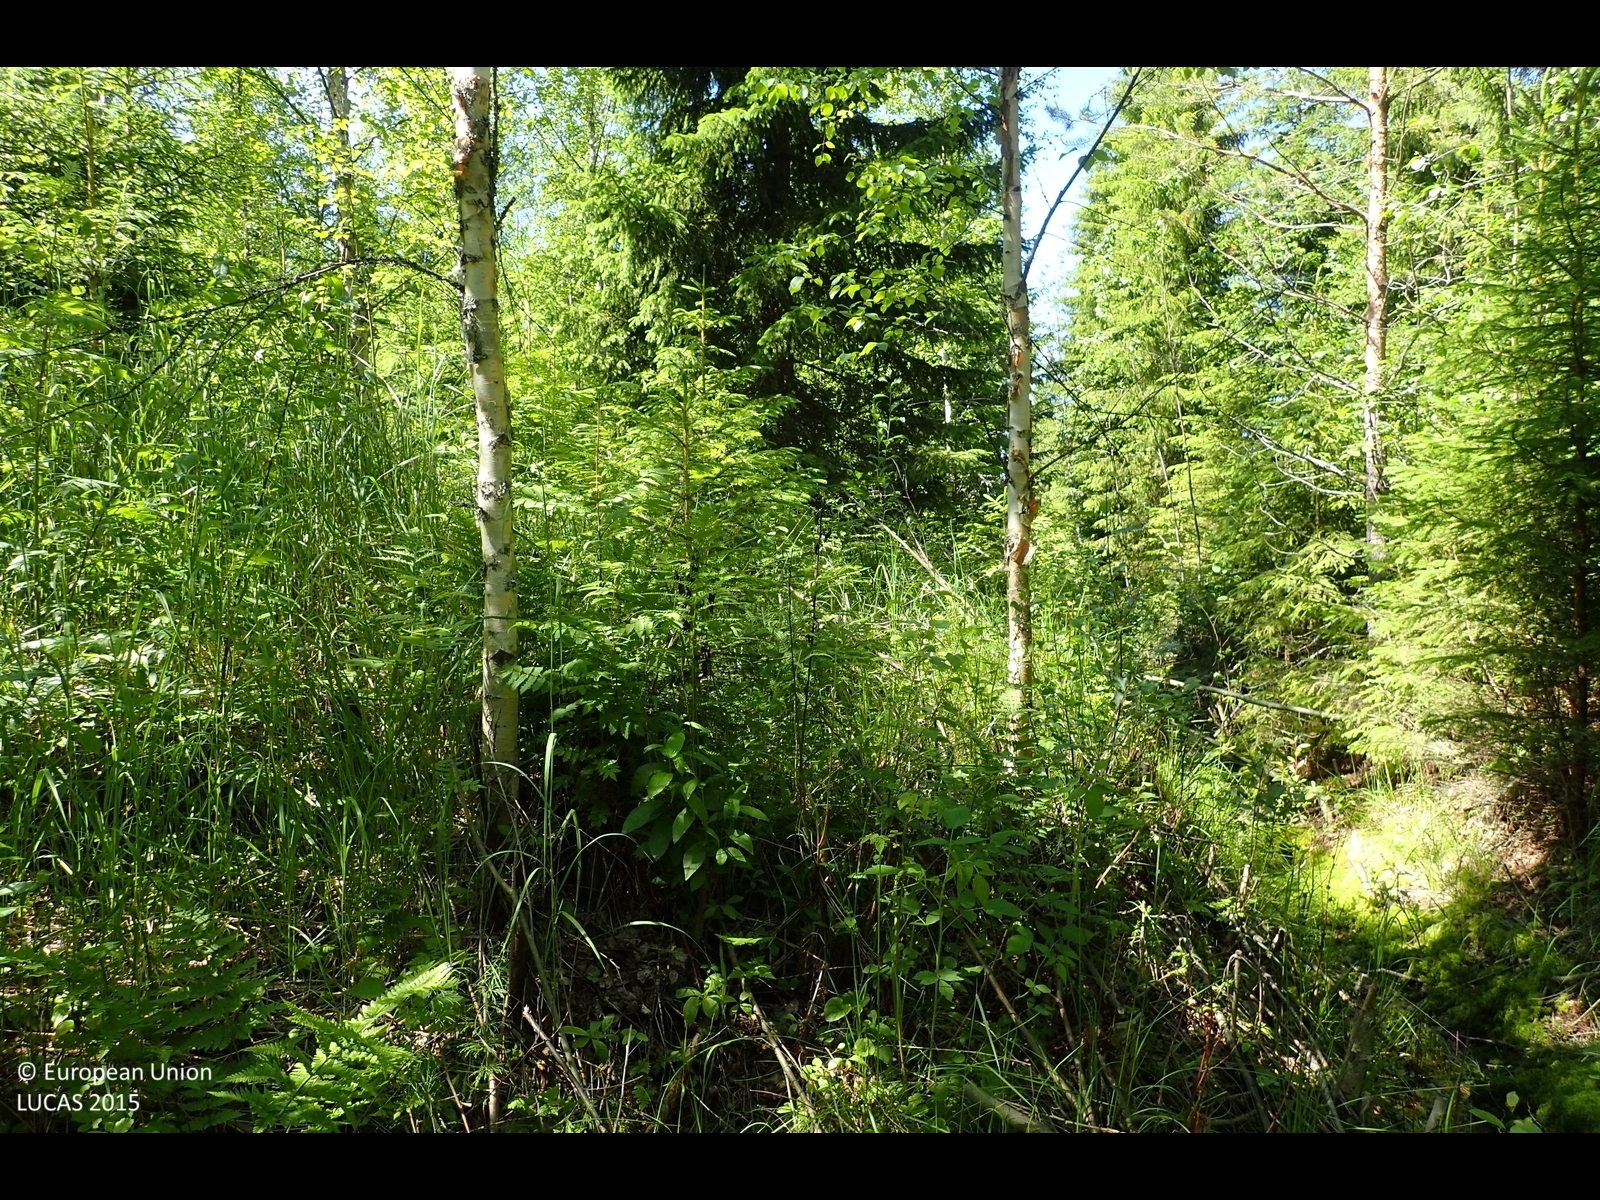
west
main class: Woodland
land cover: Broadleaved woodland
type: boreal forest
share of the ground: > 75 %
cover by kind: broadleaved forest trees 60 %, herbaceous plants 25 %, coniferous forest trees 15 %
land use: Forestry
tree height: > 5 m
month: July
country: FI
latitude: 62.4888
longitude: 21.6298
